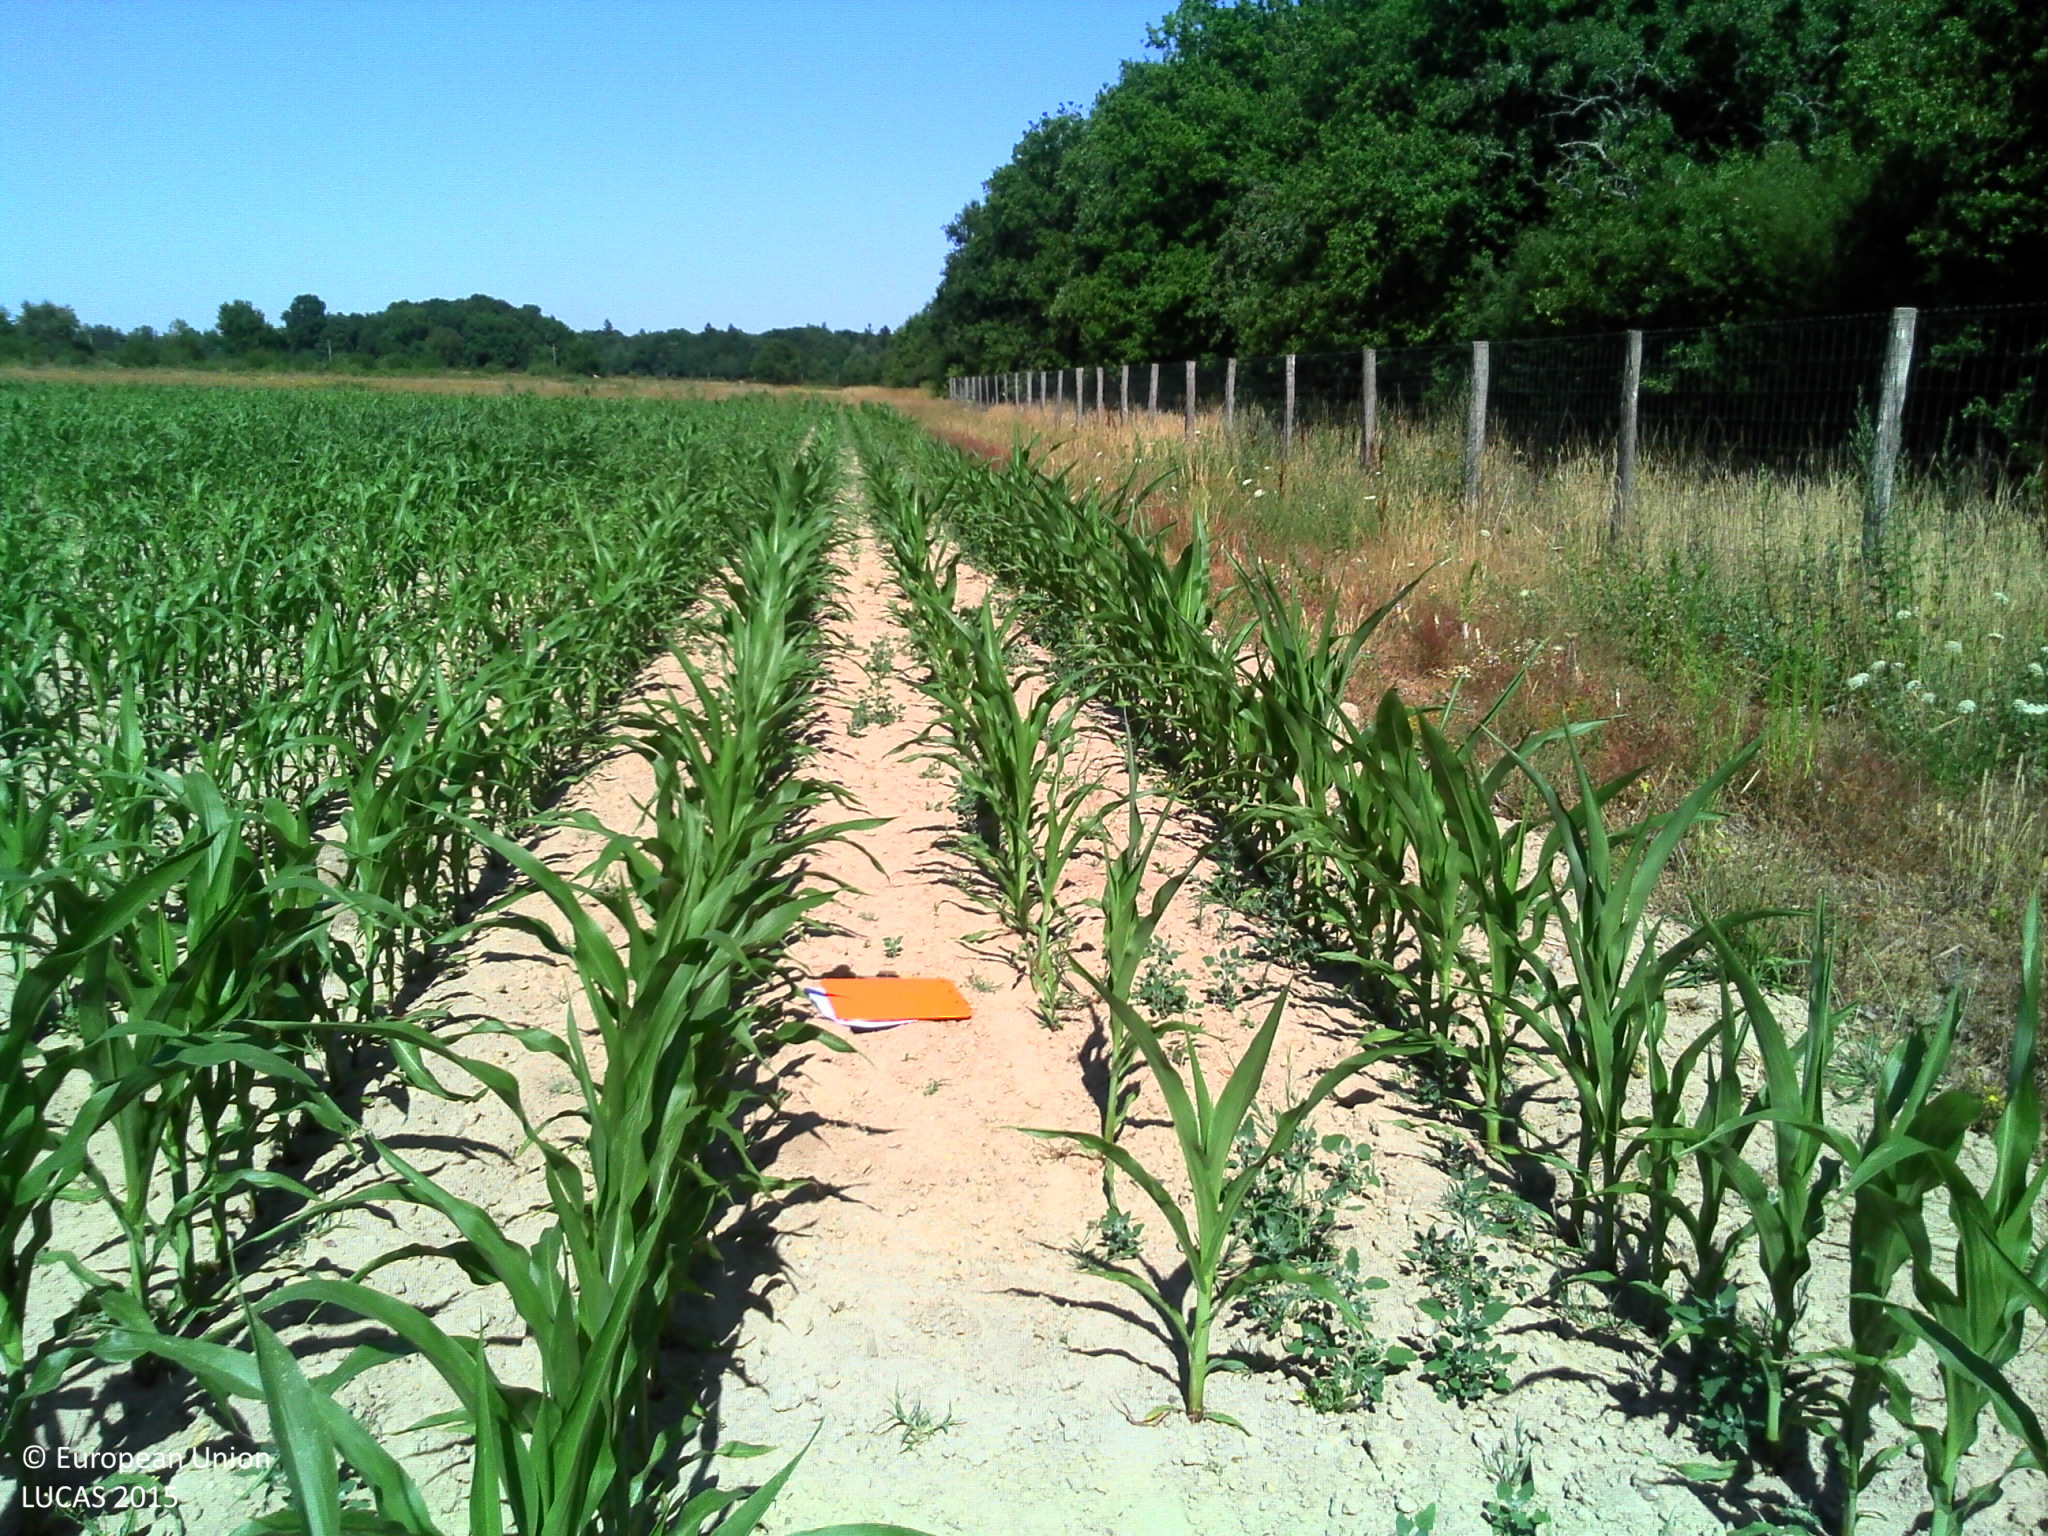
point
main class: Cropland
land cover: Maize
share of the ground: 25 - 50 %
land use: Agriculture (excluding fallow land and kitchen gardens)
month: July
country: FR
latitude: 47.9323
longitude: 2.5085
